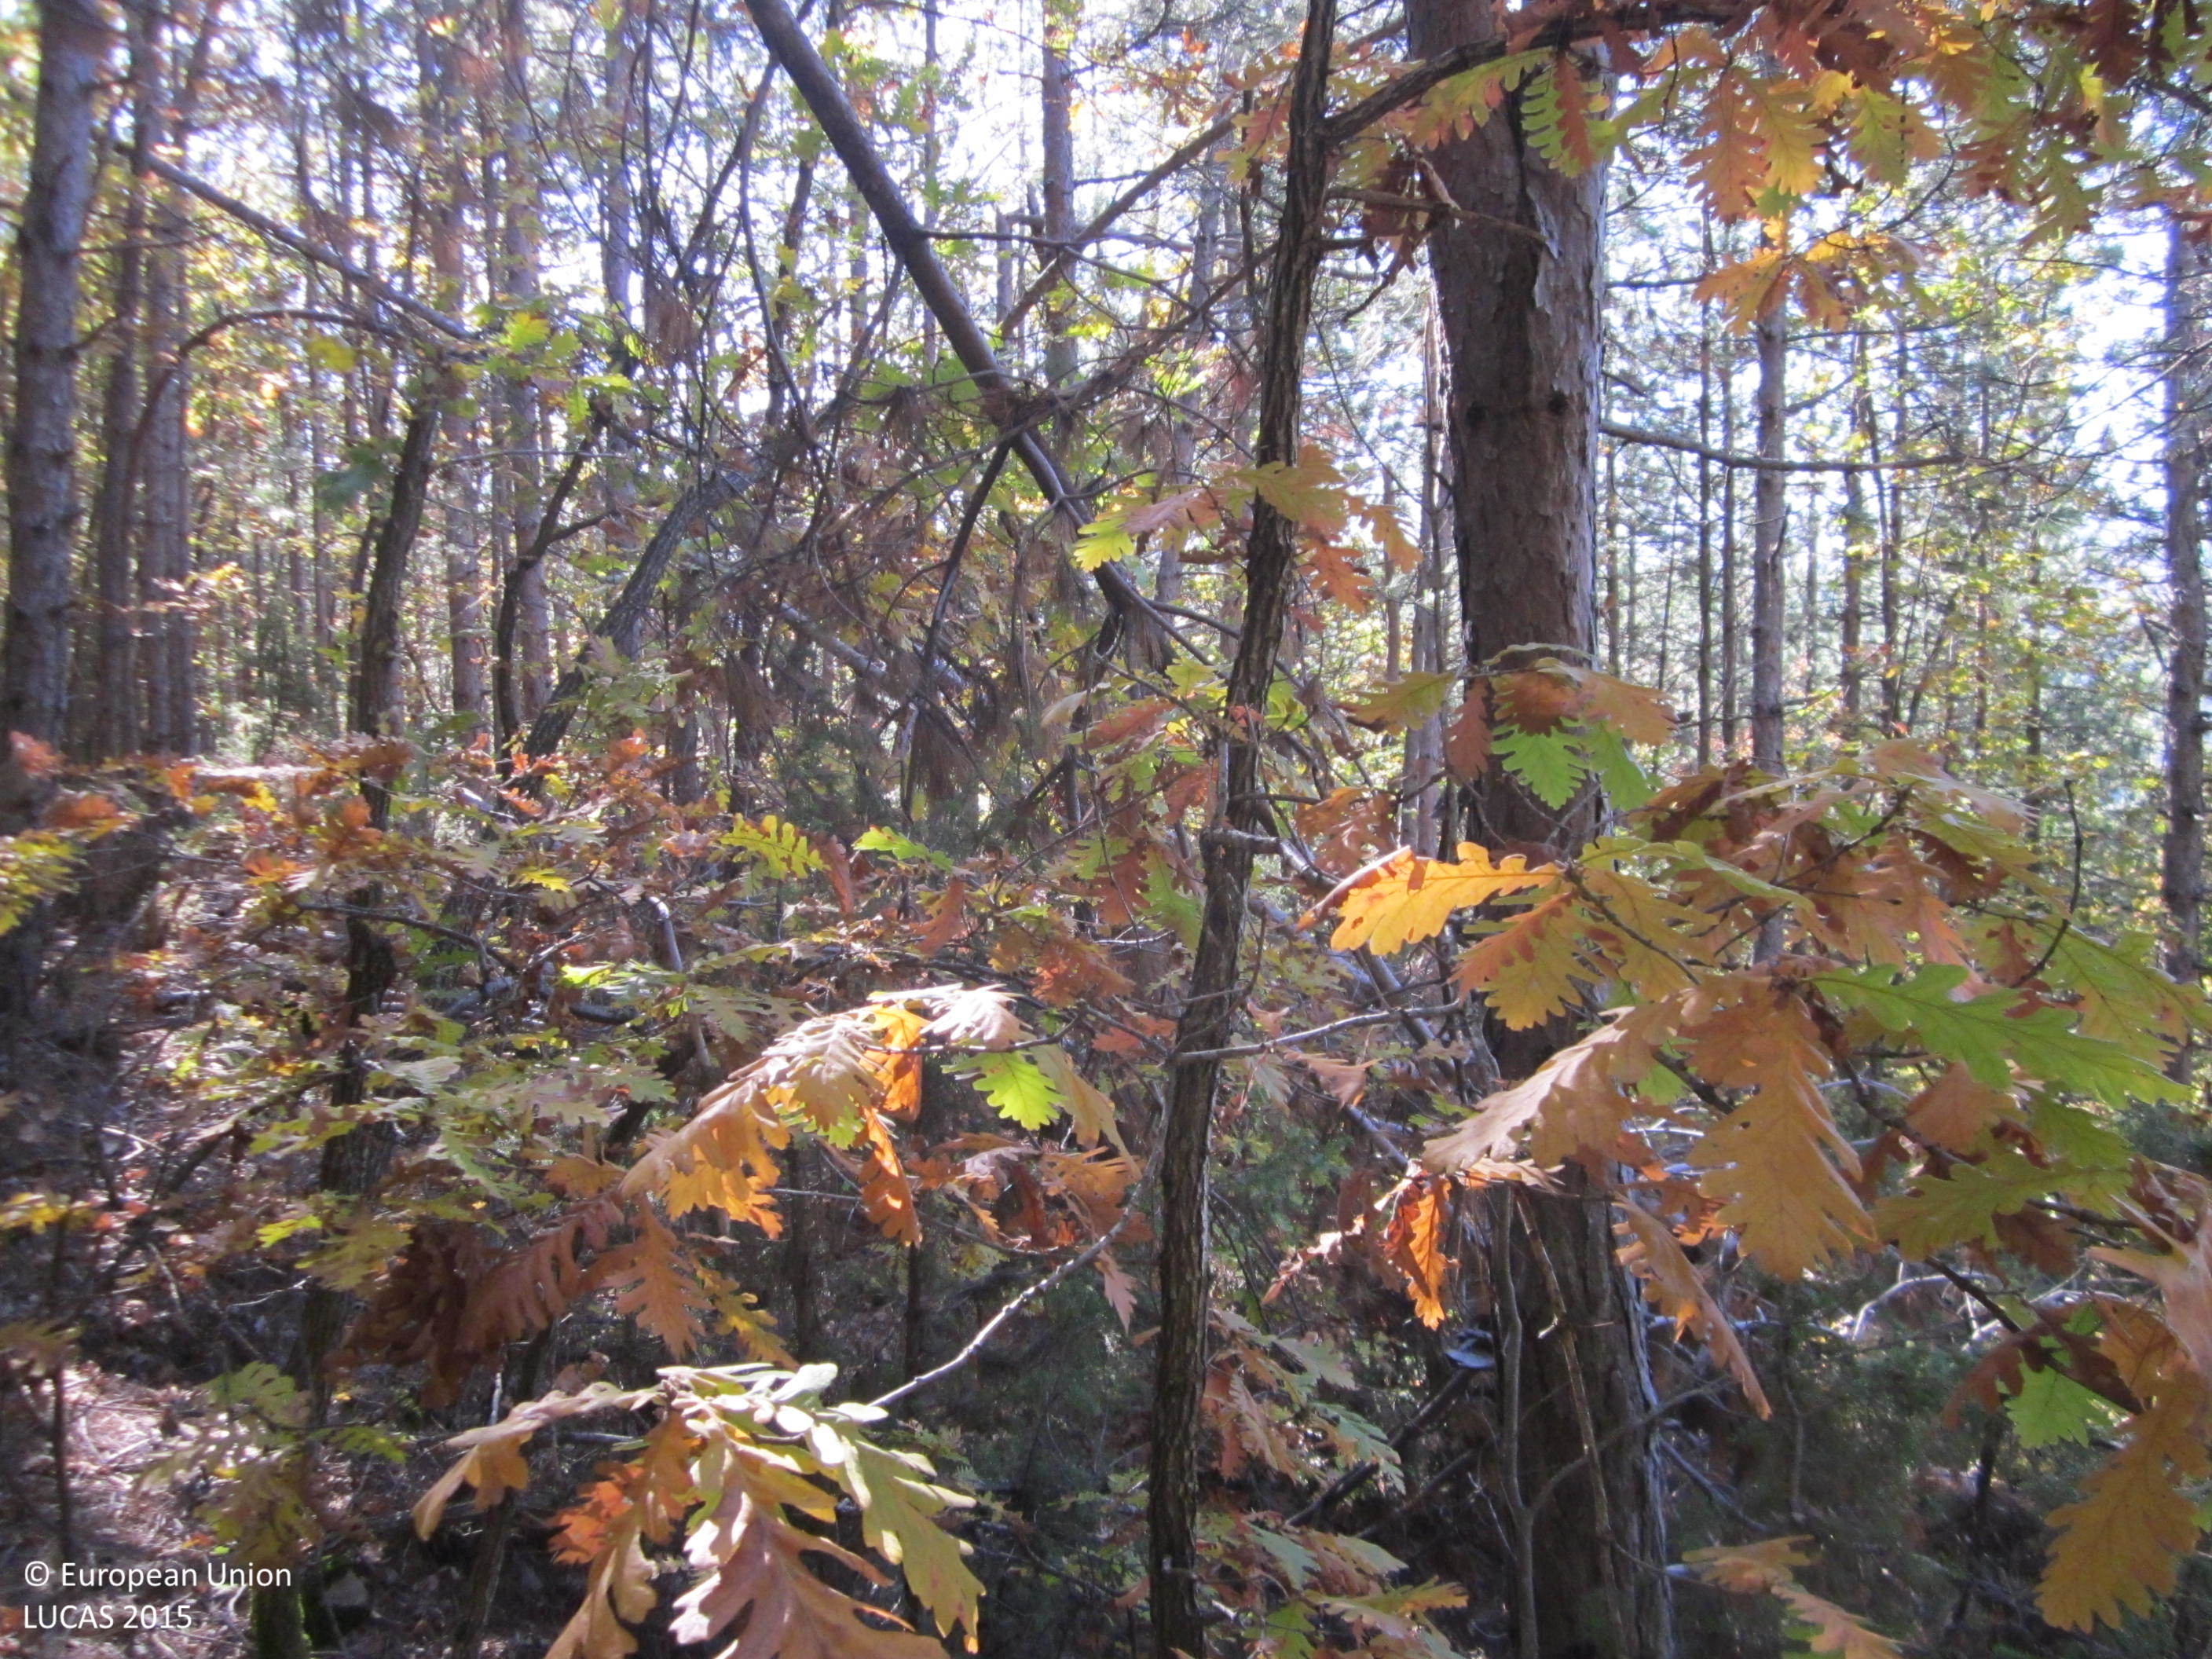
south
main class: Woodland
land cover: Pine dominated mixed woodland
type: hemiboreal forest and nemoral coniferous forest and mixed broadleaved-coniferous forest
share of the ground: > 75 %
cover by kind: coniferous forest trees 60 %, broadleaved forest trees 20 %, unconsolidated bare surface 10 %, shrubs 5 %, lichens and mosses 5 %
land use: Forestry
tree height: > 5 m
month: November
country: BG
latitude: 41.4033
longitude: 25.6941
